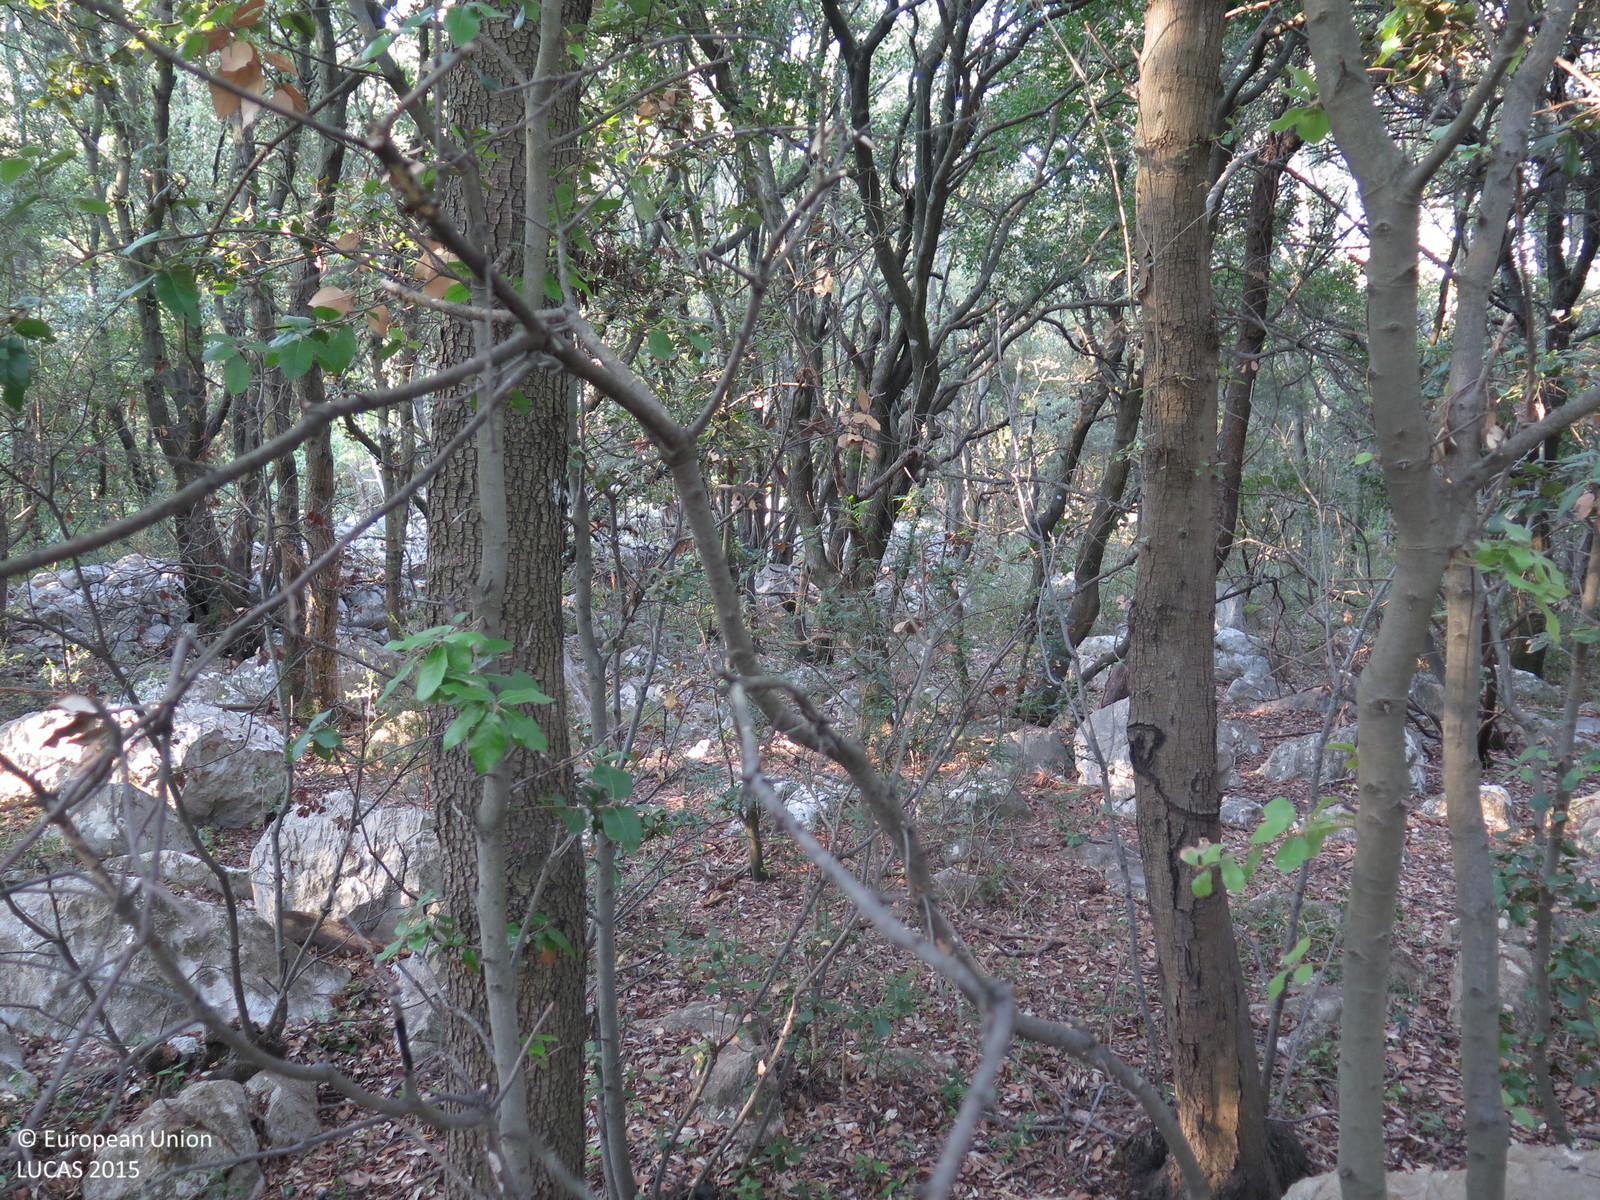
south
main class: Woodland
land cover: Broadleaved woodland
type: thermophilous deciduous forest
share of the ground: > 75 %
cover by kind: broadleaved forest trees 90 %, shrubs 5 %, unconsolidated bare surface 5 %
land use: Forestry
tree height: > 5 m
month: August
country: HR
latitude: 44.7676
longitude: 14.7065
